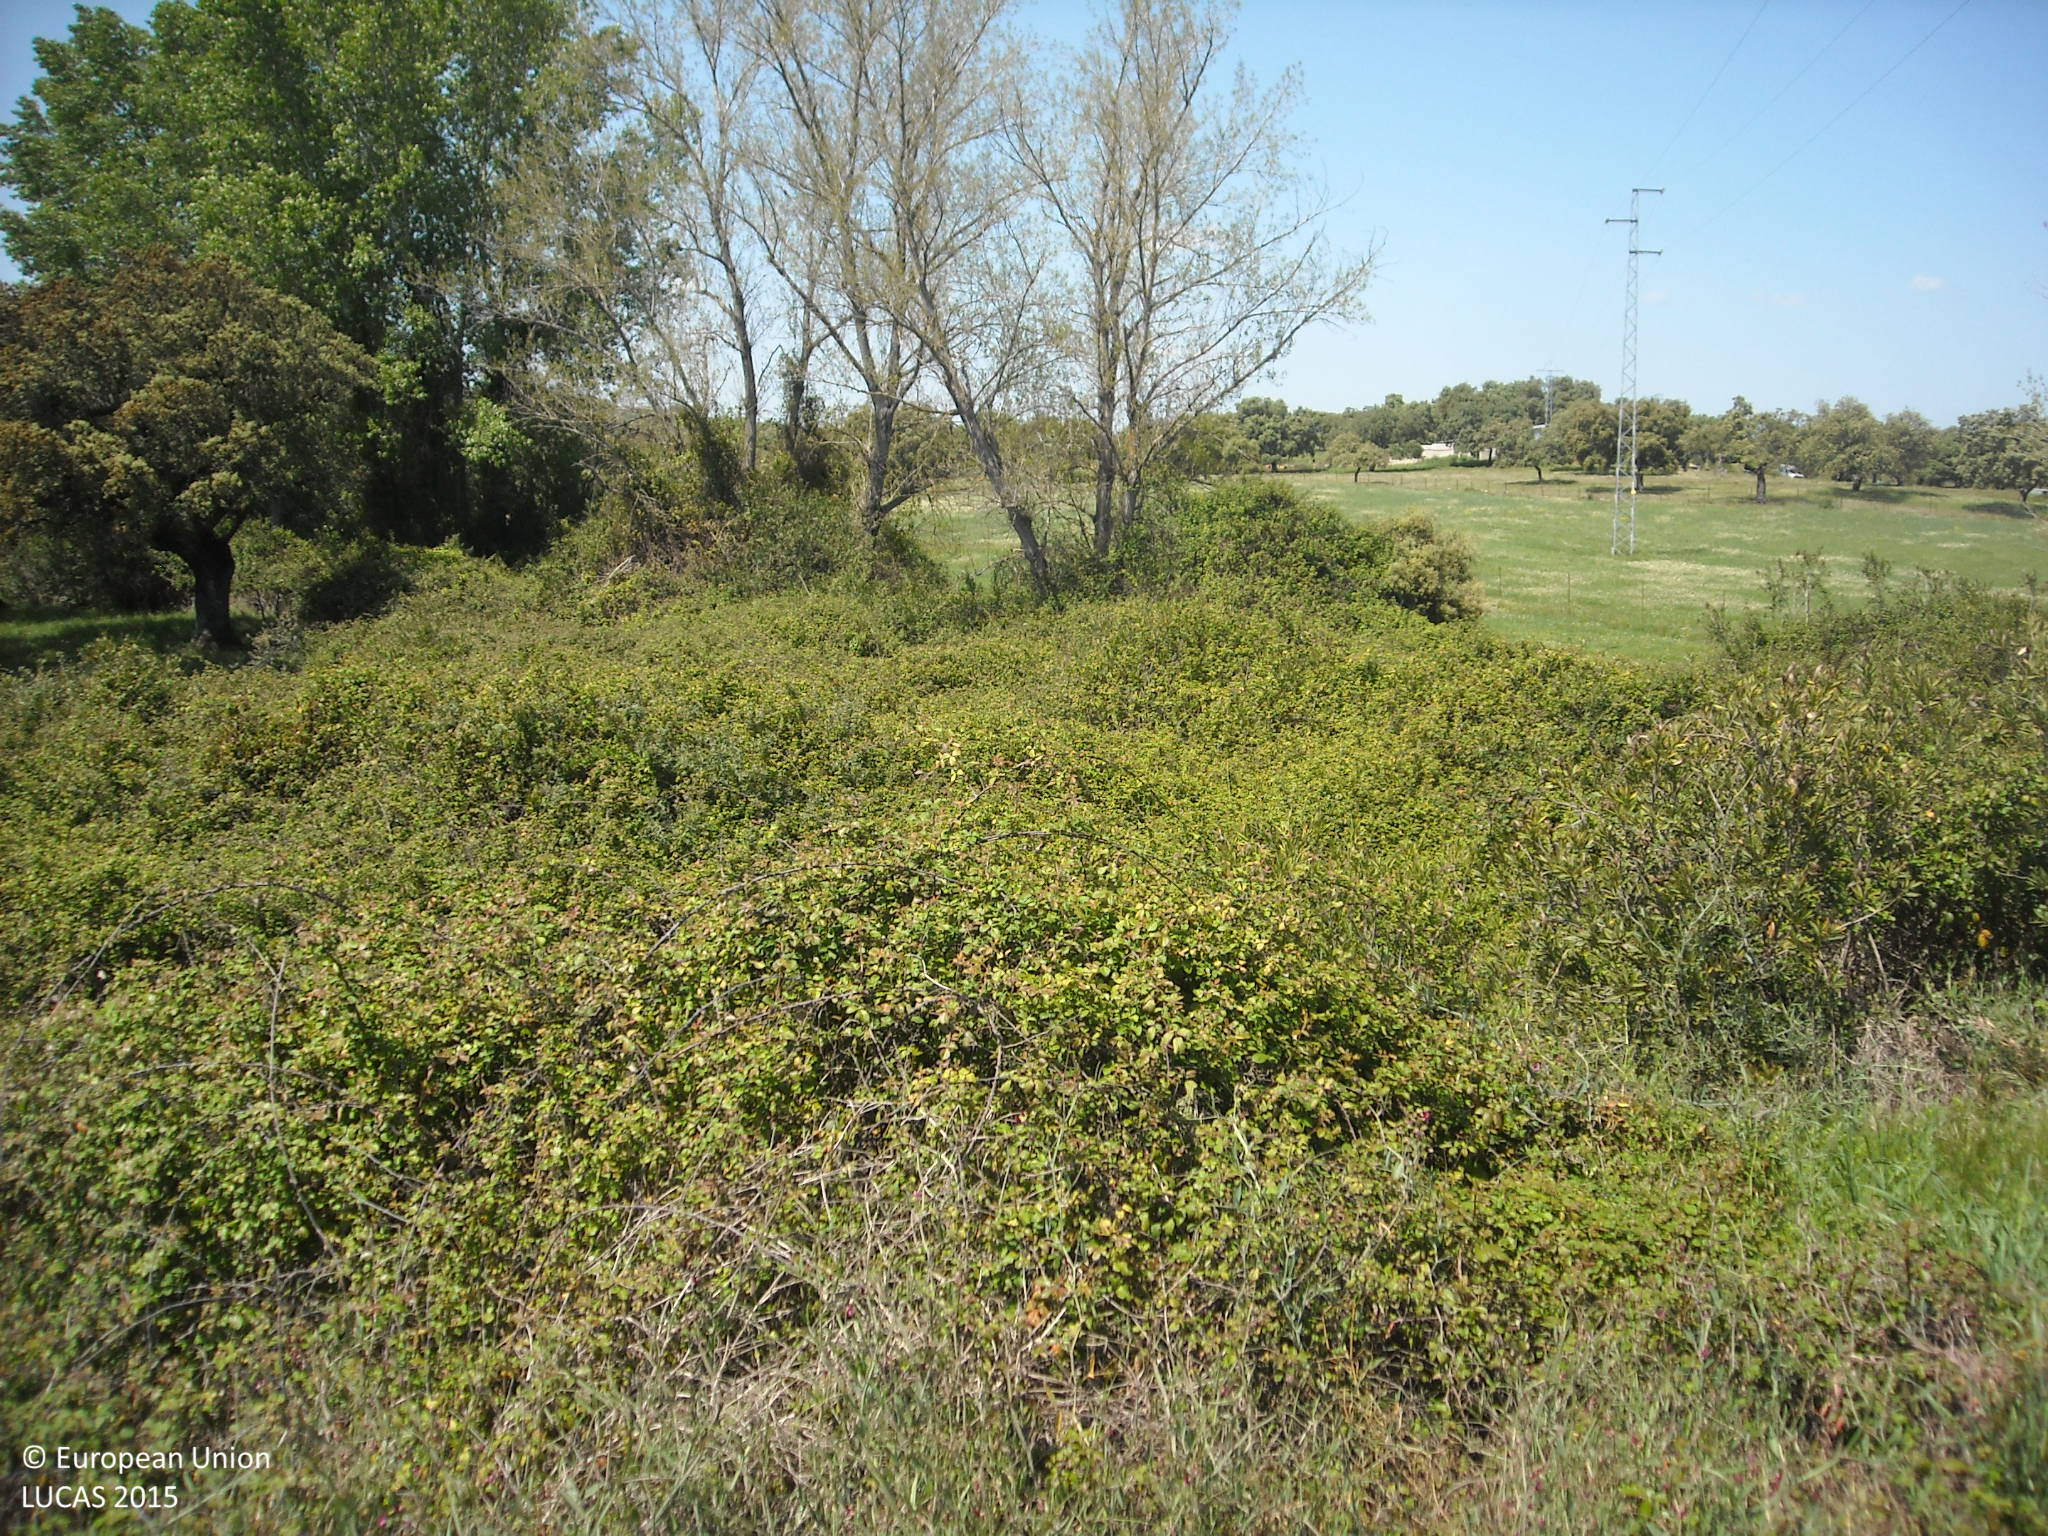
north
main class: Woodland
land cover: Broadleaved woodland
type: broadleaved evergreen forest
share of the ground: 25 - 50 %
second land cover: Grassland without tree/shrub cover
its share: > 75 %
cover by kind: herbaceous plants 75 %, broadleaved forest trees 25 %
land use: Forestry
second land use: Agriculture (excluding fallow land and kitchen gardens)
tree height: > 5 m
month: April
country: ES
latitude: 37.7695
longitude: -6.5125
